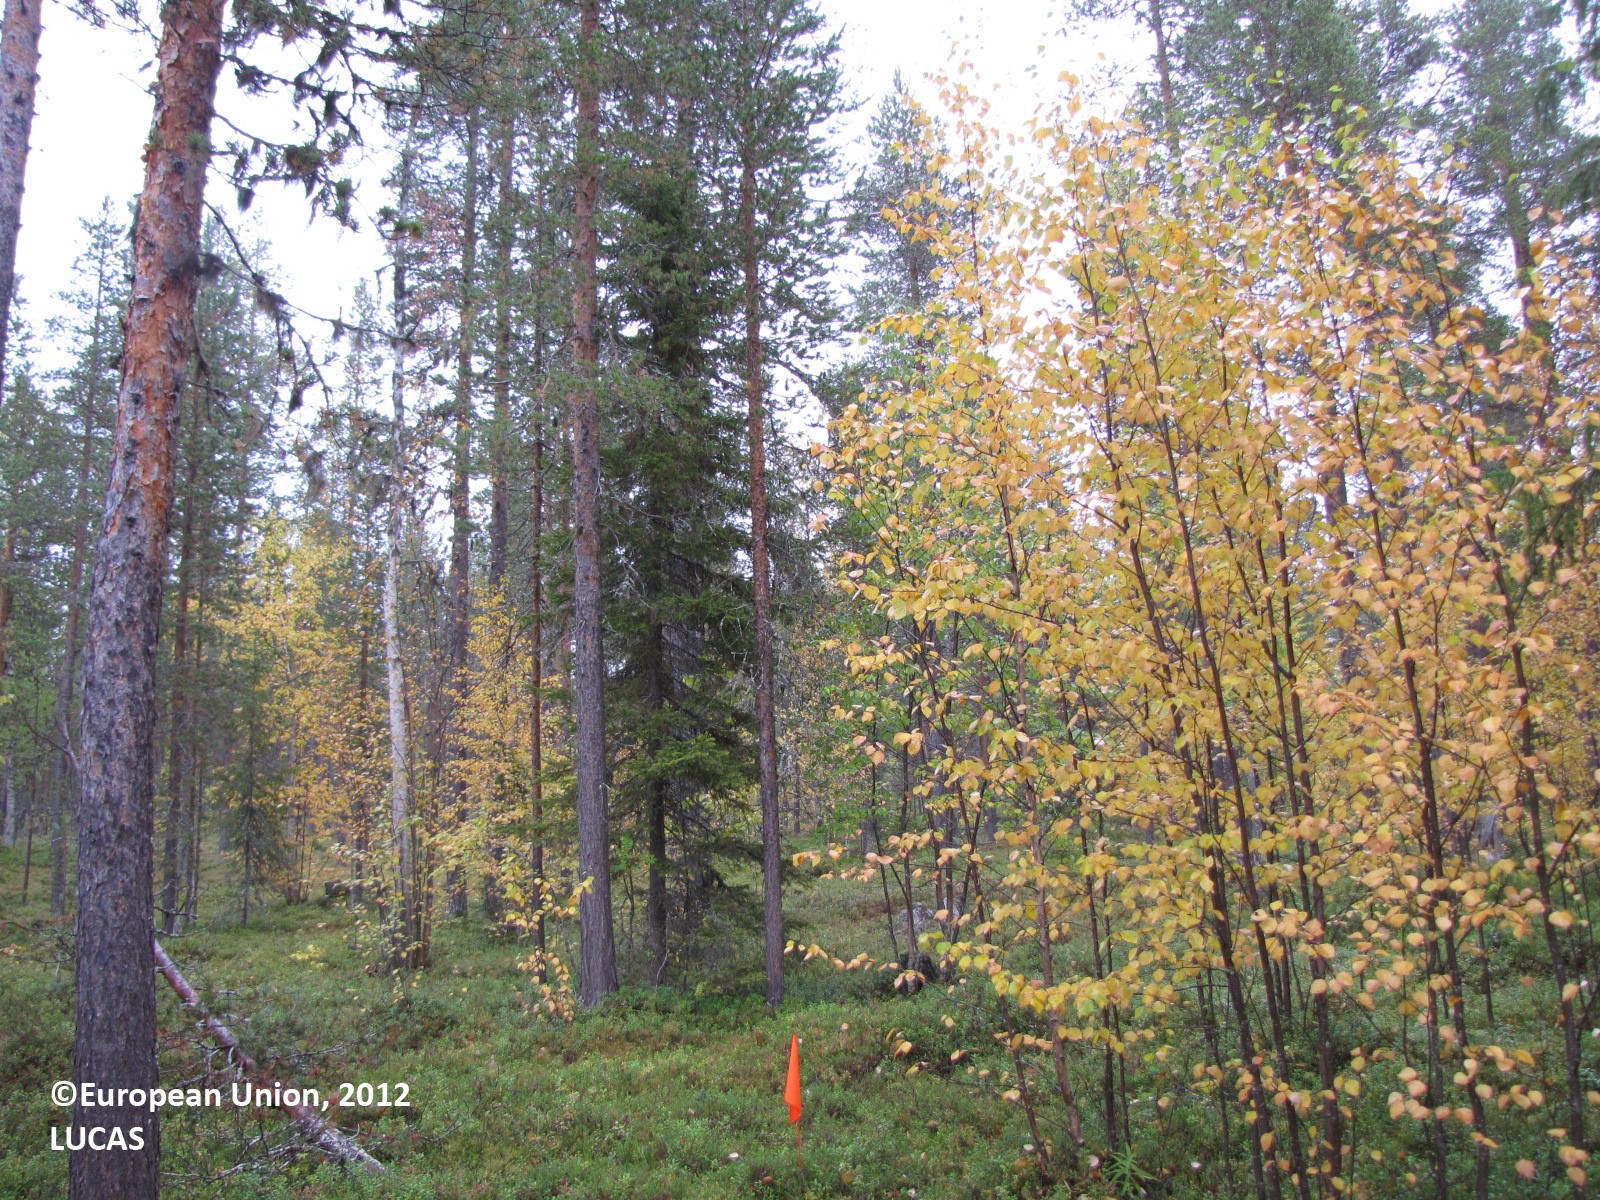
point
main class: Woodland
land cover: Pine dominated mixed woodland
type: boreal forest
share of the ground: 25 - 50 %
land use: Forestry
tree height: > 5 m
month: September
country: FI
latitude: 67.6149
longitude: 25.2668
